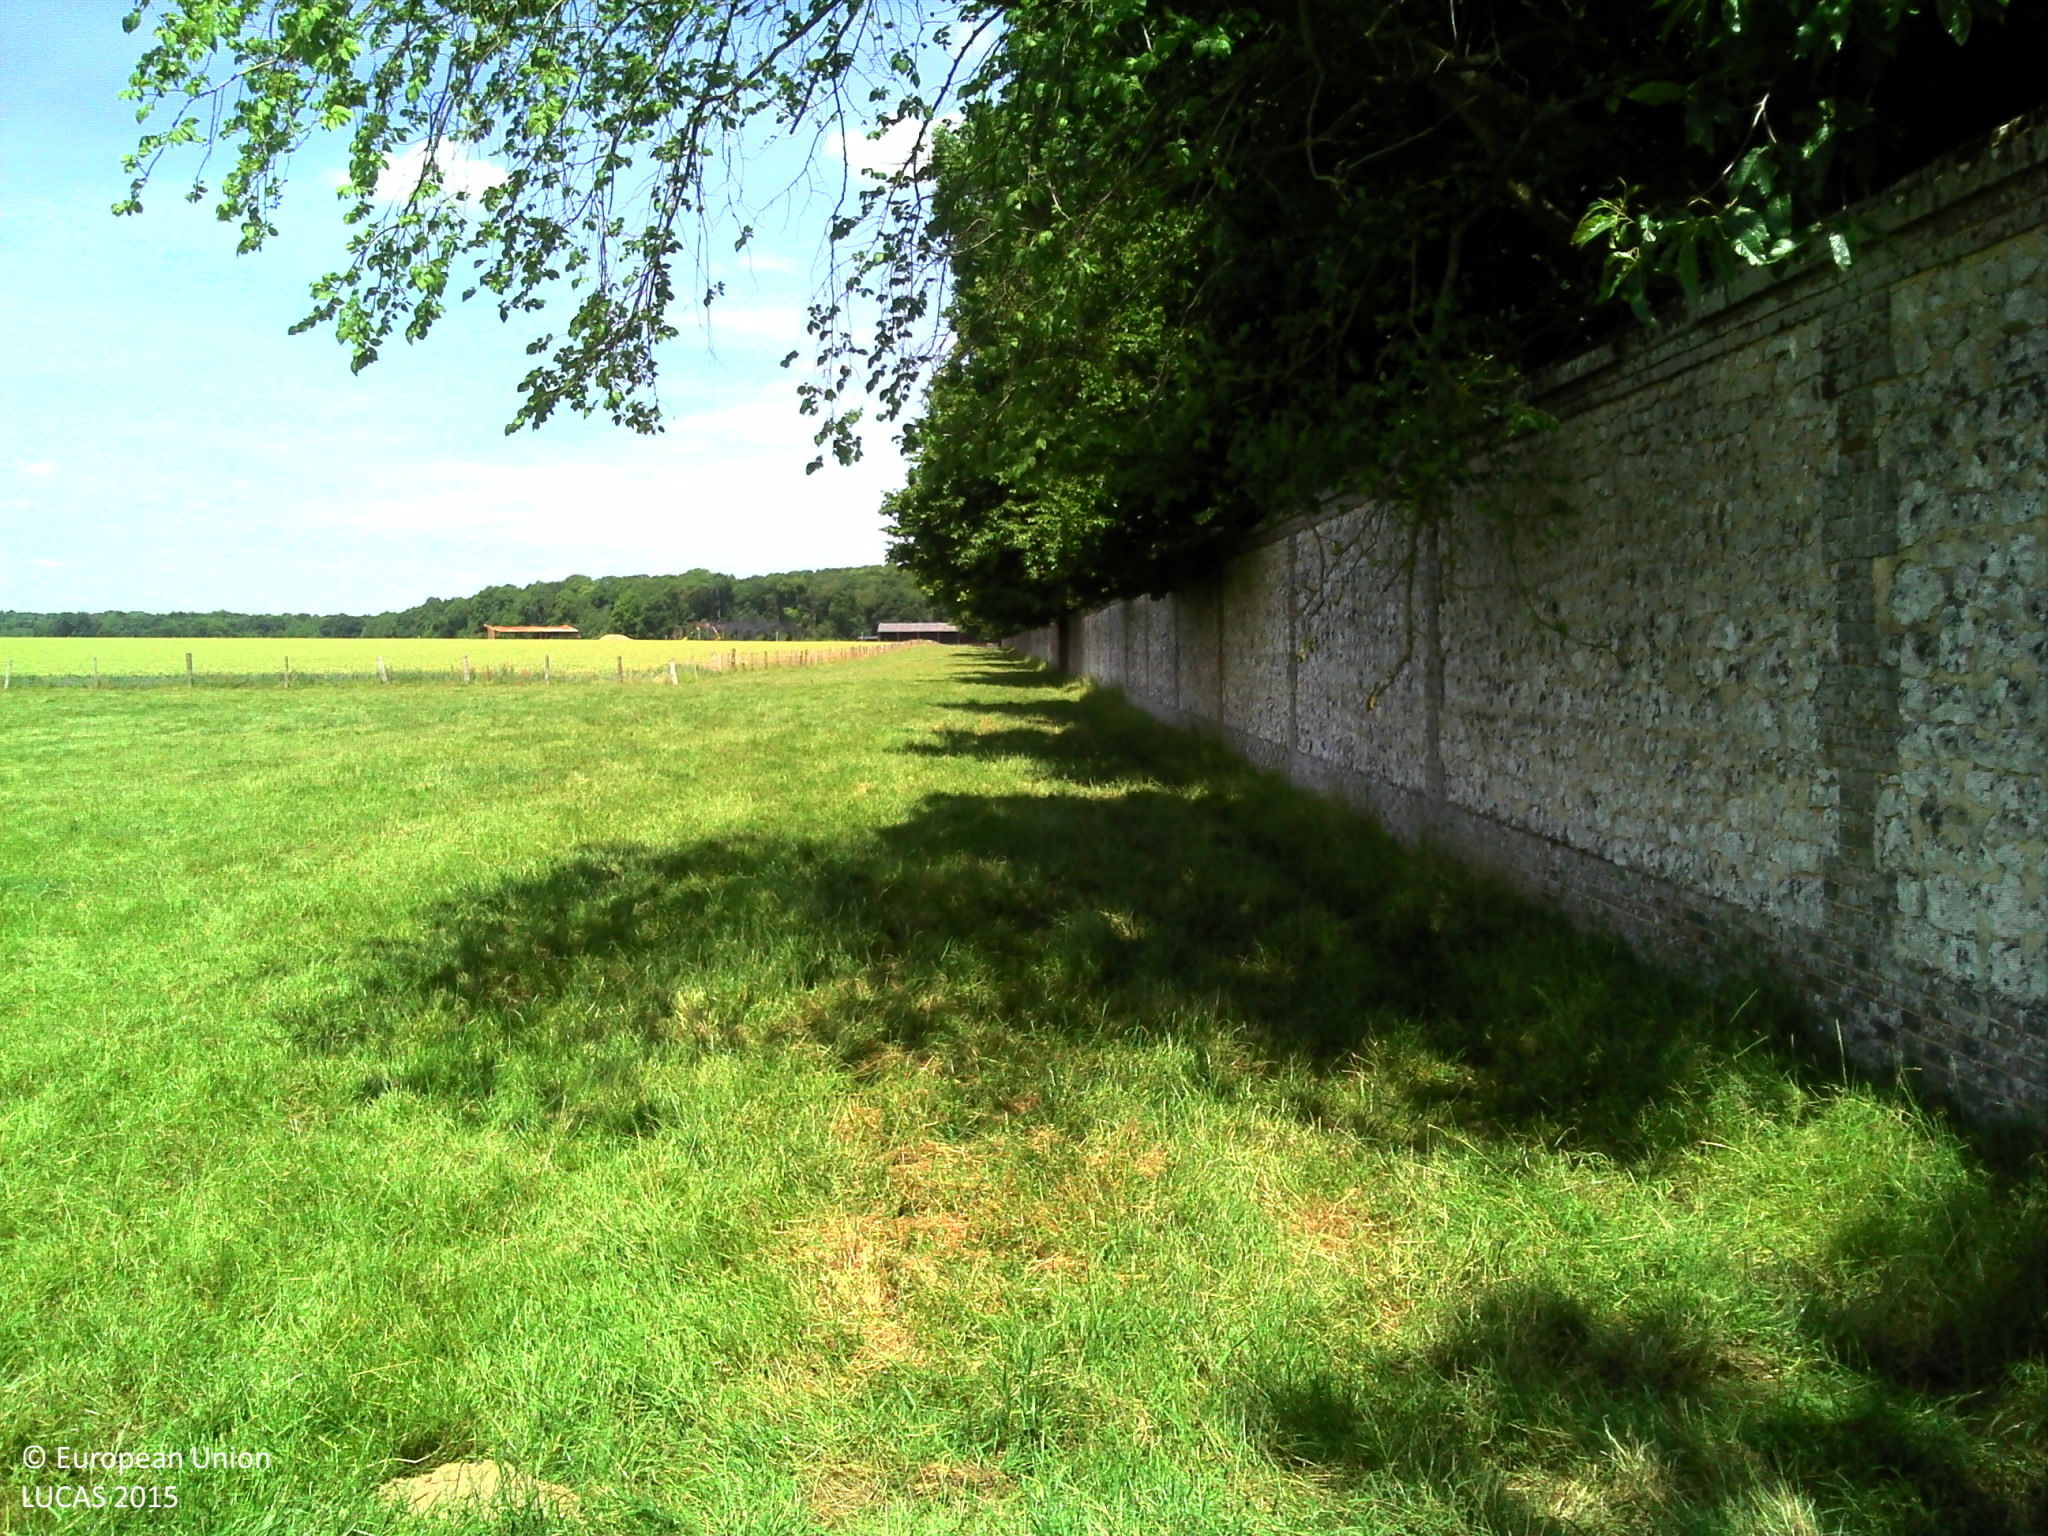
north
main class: Woodland
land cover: Broadleaved woodland
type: mesophytic deciduous forest
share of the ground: > 75 %
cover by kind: broadleaved forest trees 80 %, herbaceous plants 10 %, consolidated bare surface 10 %
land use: Forestry
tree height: > 5 m
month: June
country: FR
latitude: 49.1087
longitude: 1.0608
